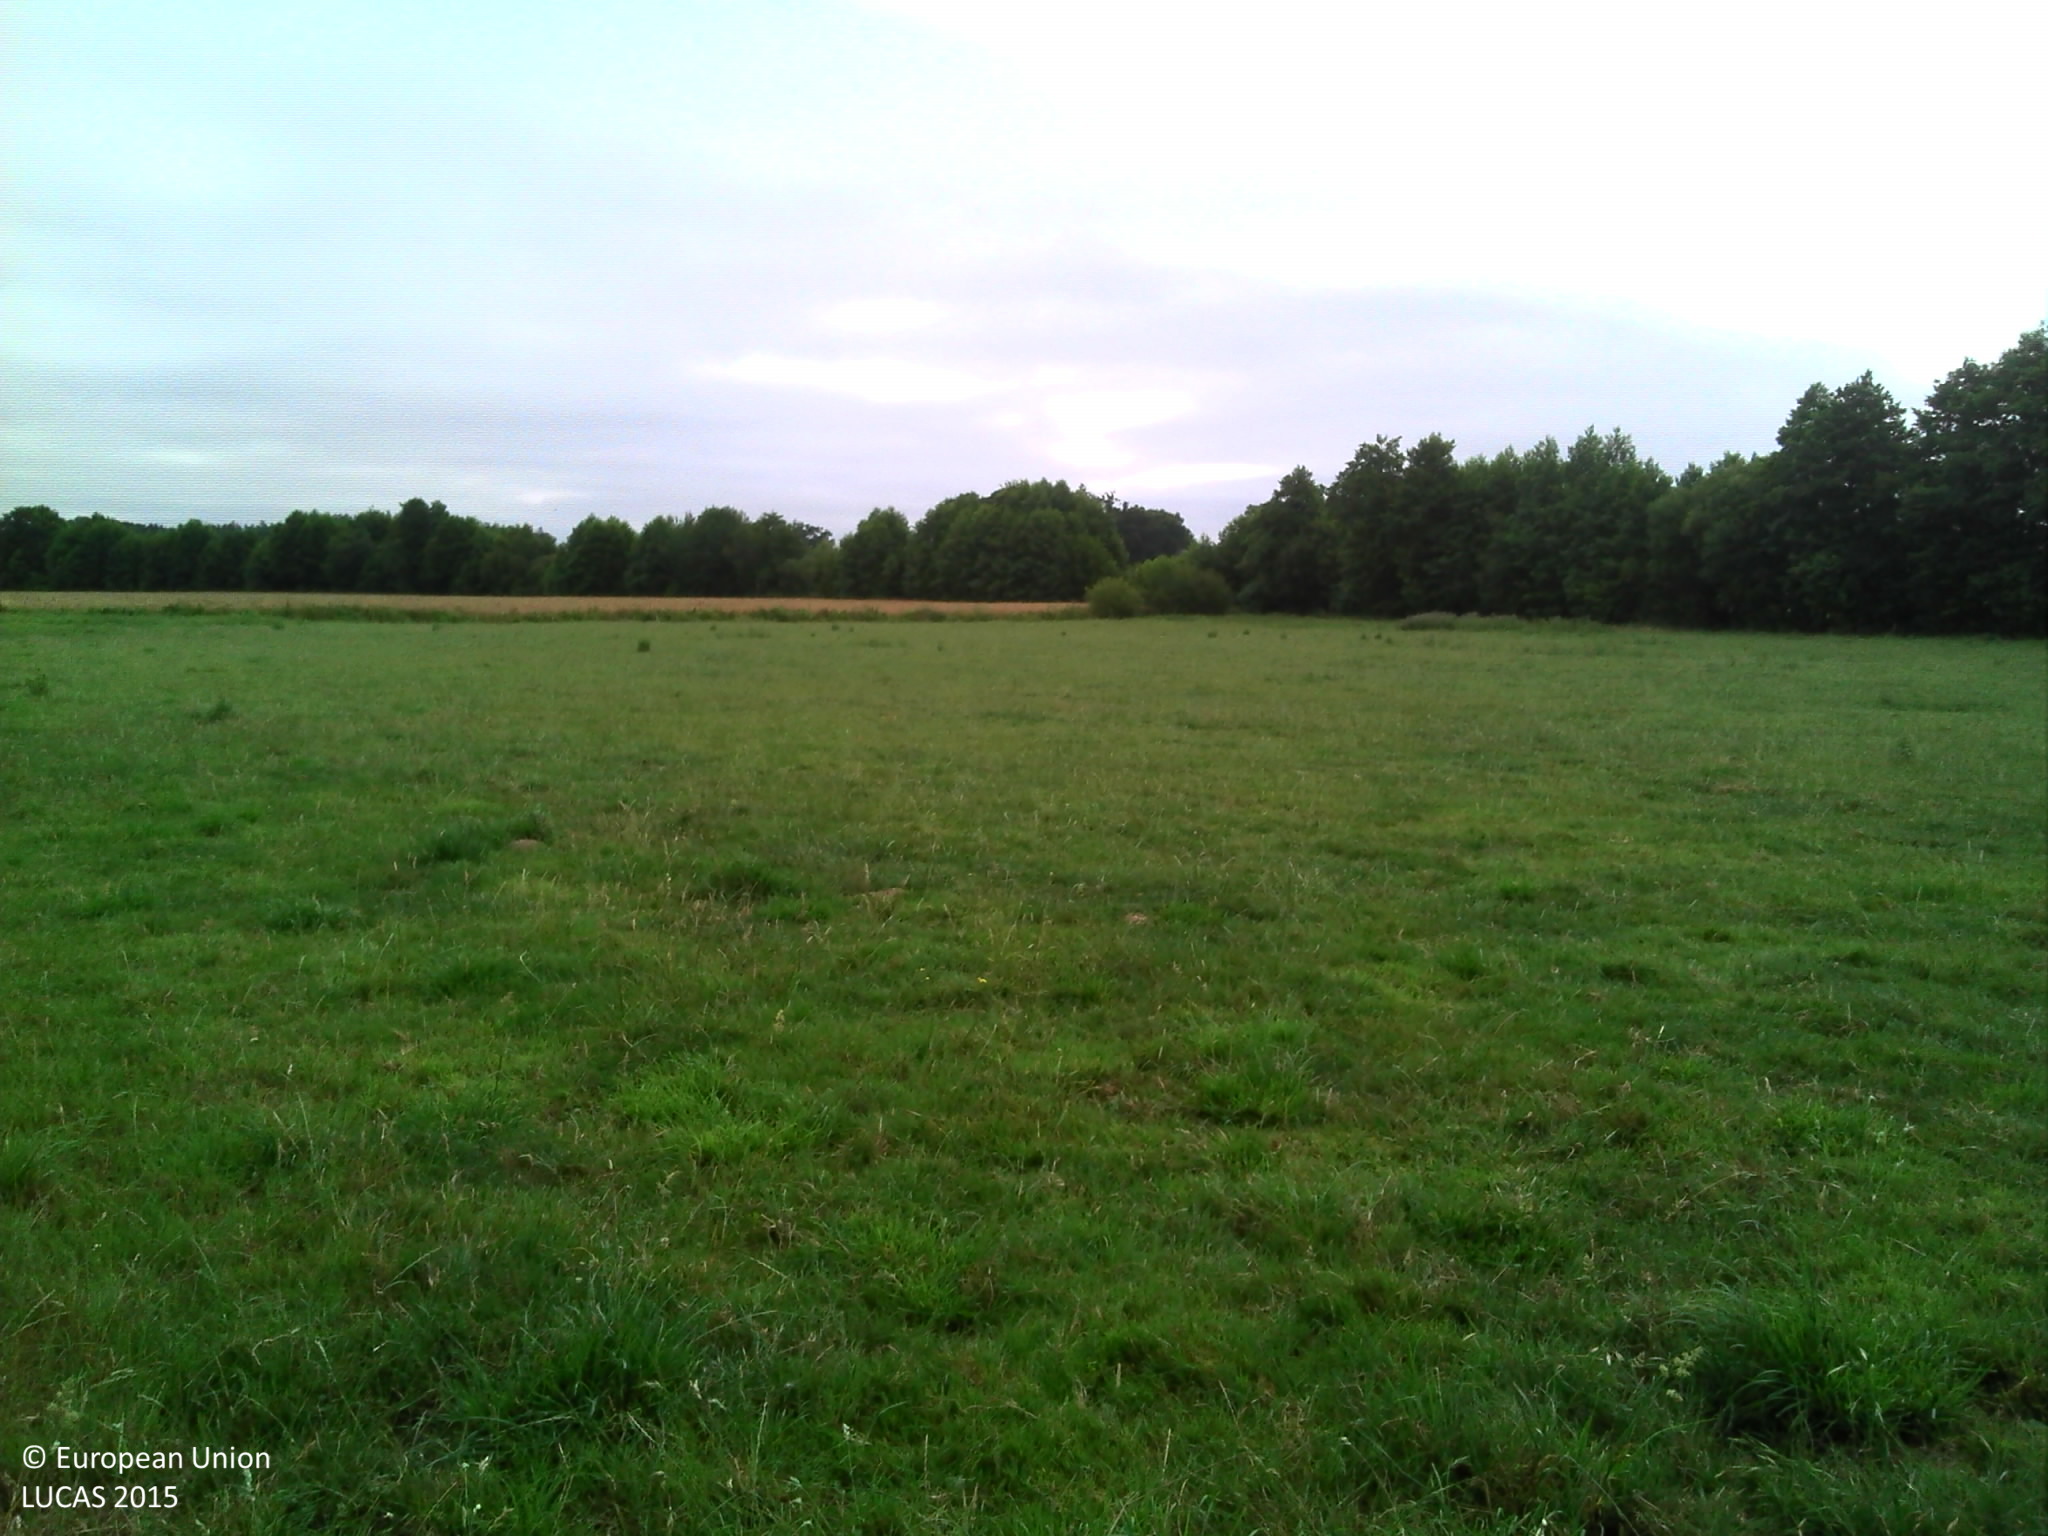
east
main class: Cropland
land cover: Temporary grasslands
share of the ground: > 75 %
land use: Agriculture (excluding fallow land and kitchen gardens)
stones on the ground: 10 - 25 %
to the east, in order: Temporary grasslands; Fences; Ditches and canals; Mixed cereals for fodder; Broadleaved woodland; Inland fresh running water; Broadleaved woodland; Fences; Temporary grasslands
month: July
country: FR
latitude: 47.6154
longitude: -1.8759
